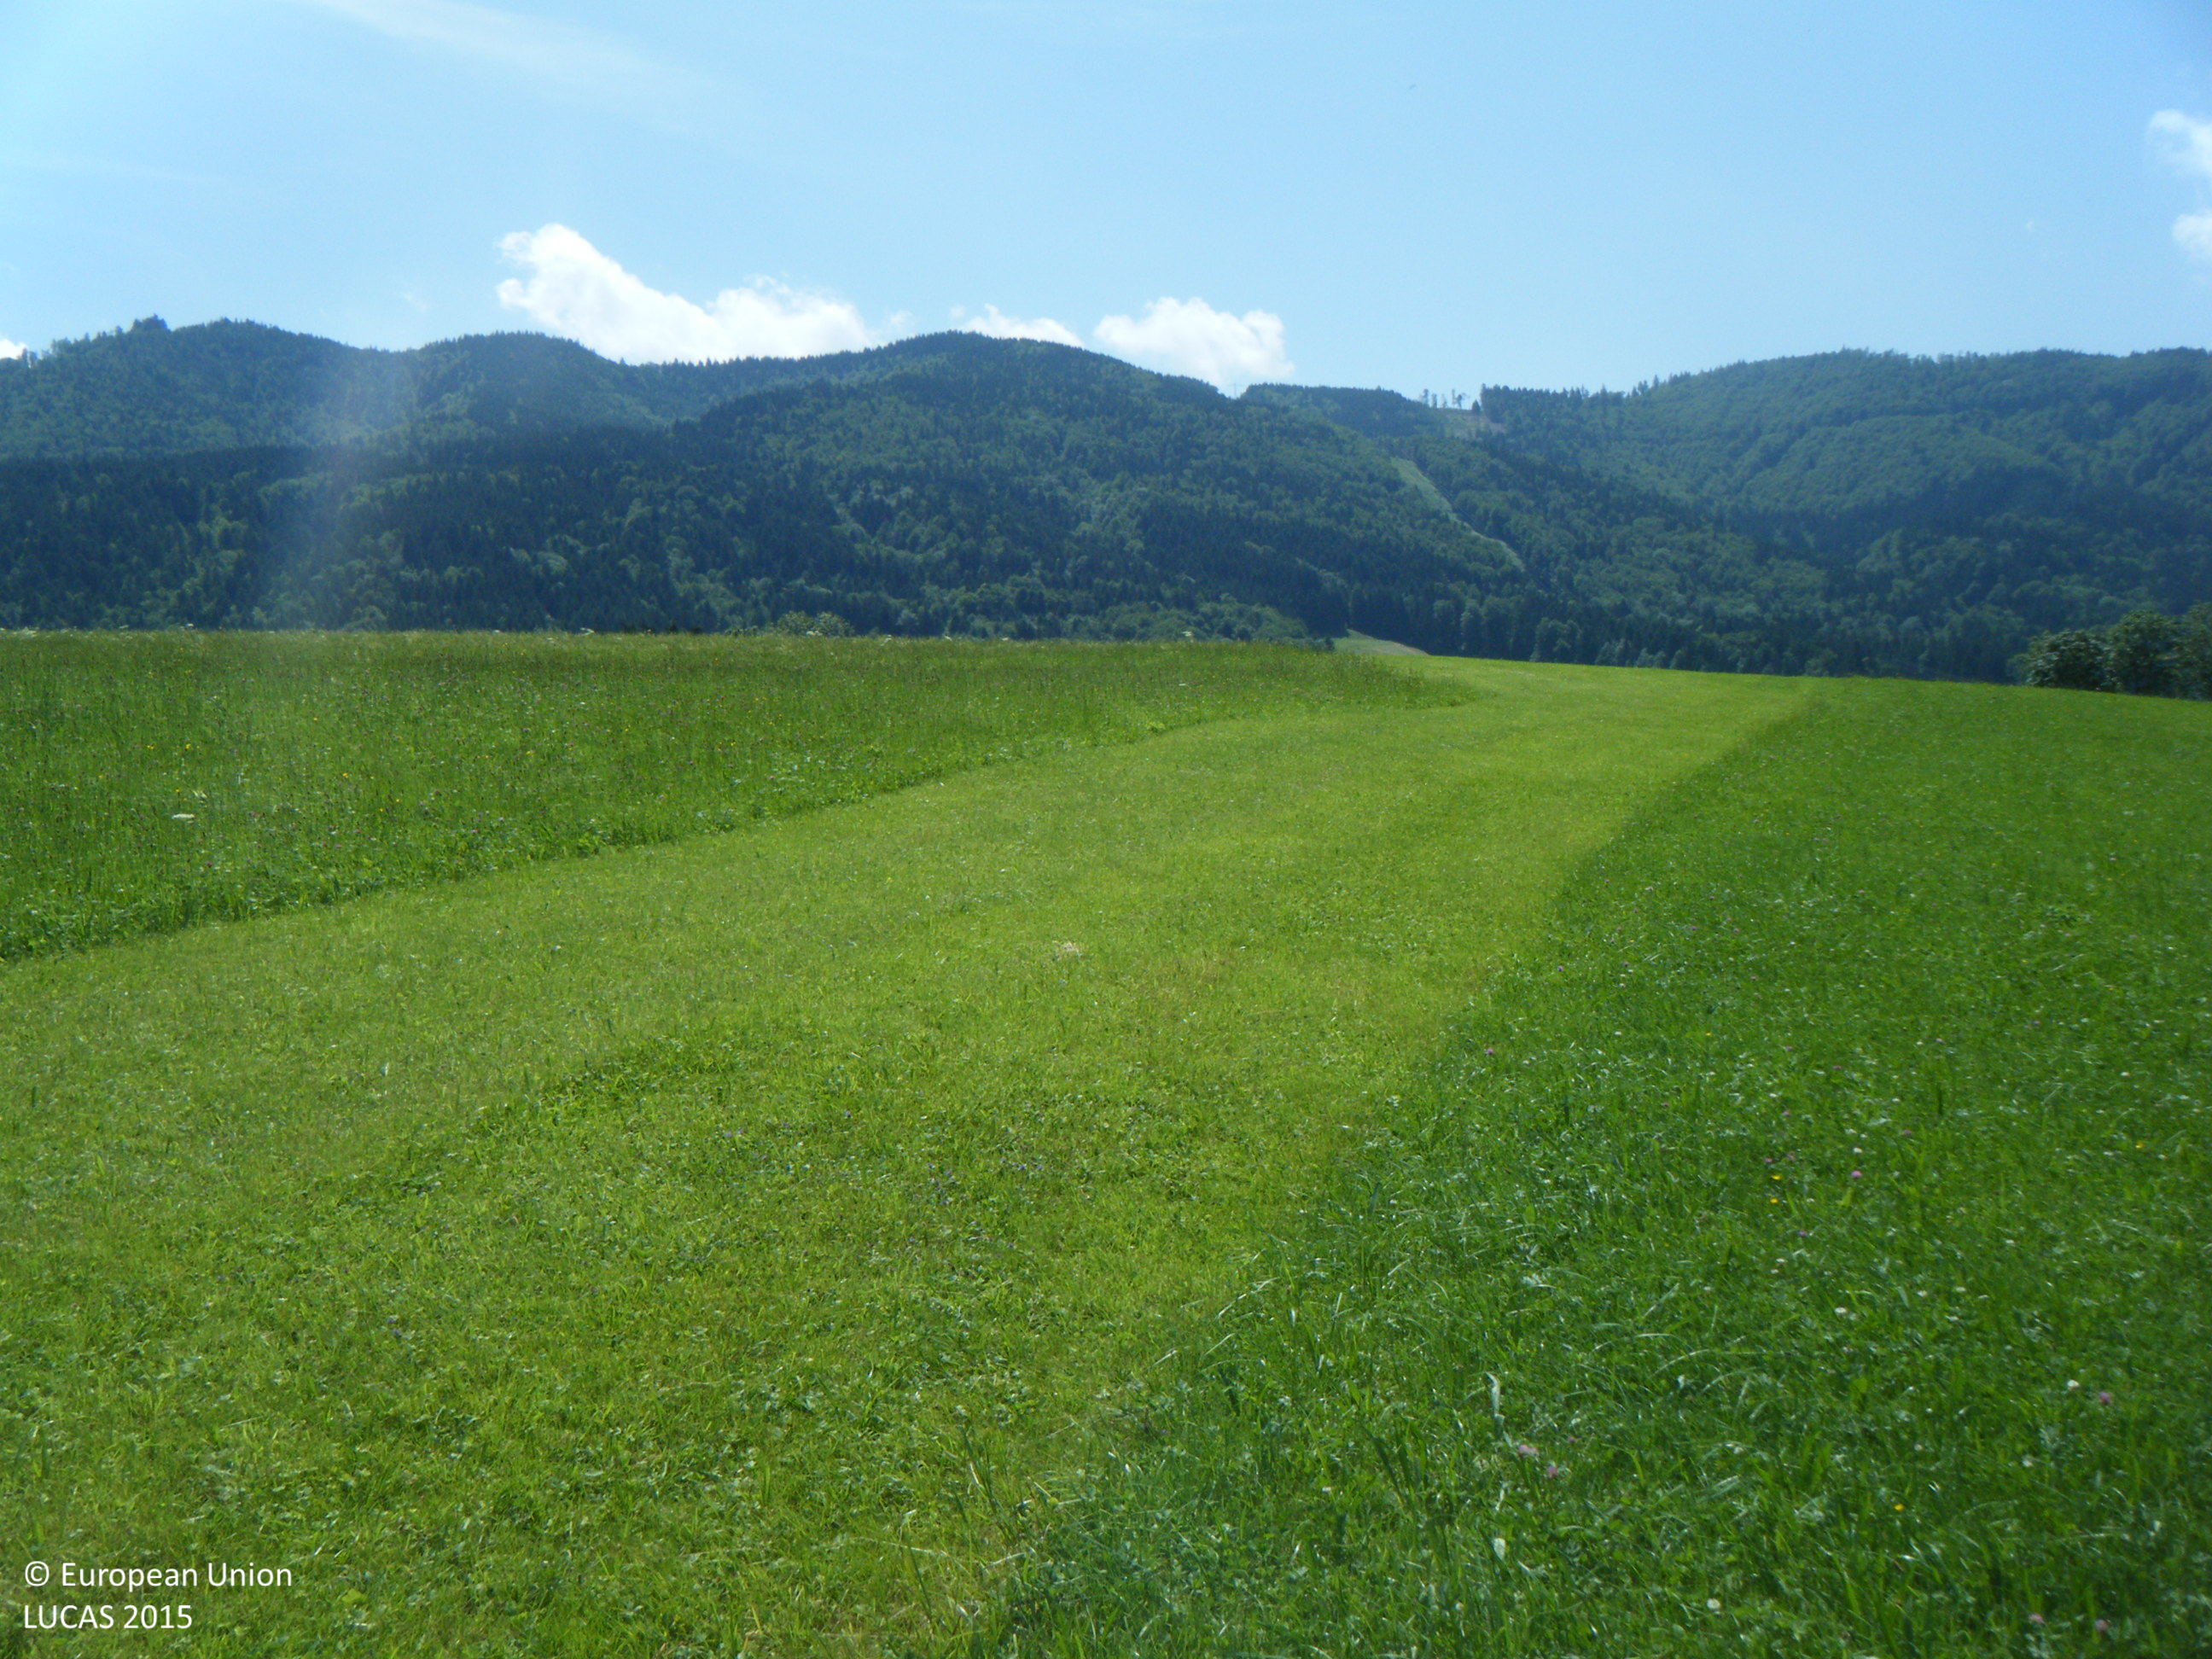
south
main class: Grassland
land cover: Grassland without tree/shrub cover
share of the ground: > 75 %
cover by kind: herbaceous plants 100 %
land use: Agriculture (excluding fallow land and kitchen gardens)
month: July
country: AT
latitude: 47.8451
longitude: 13.4598
